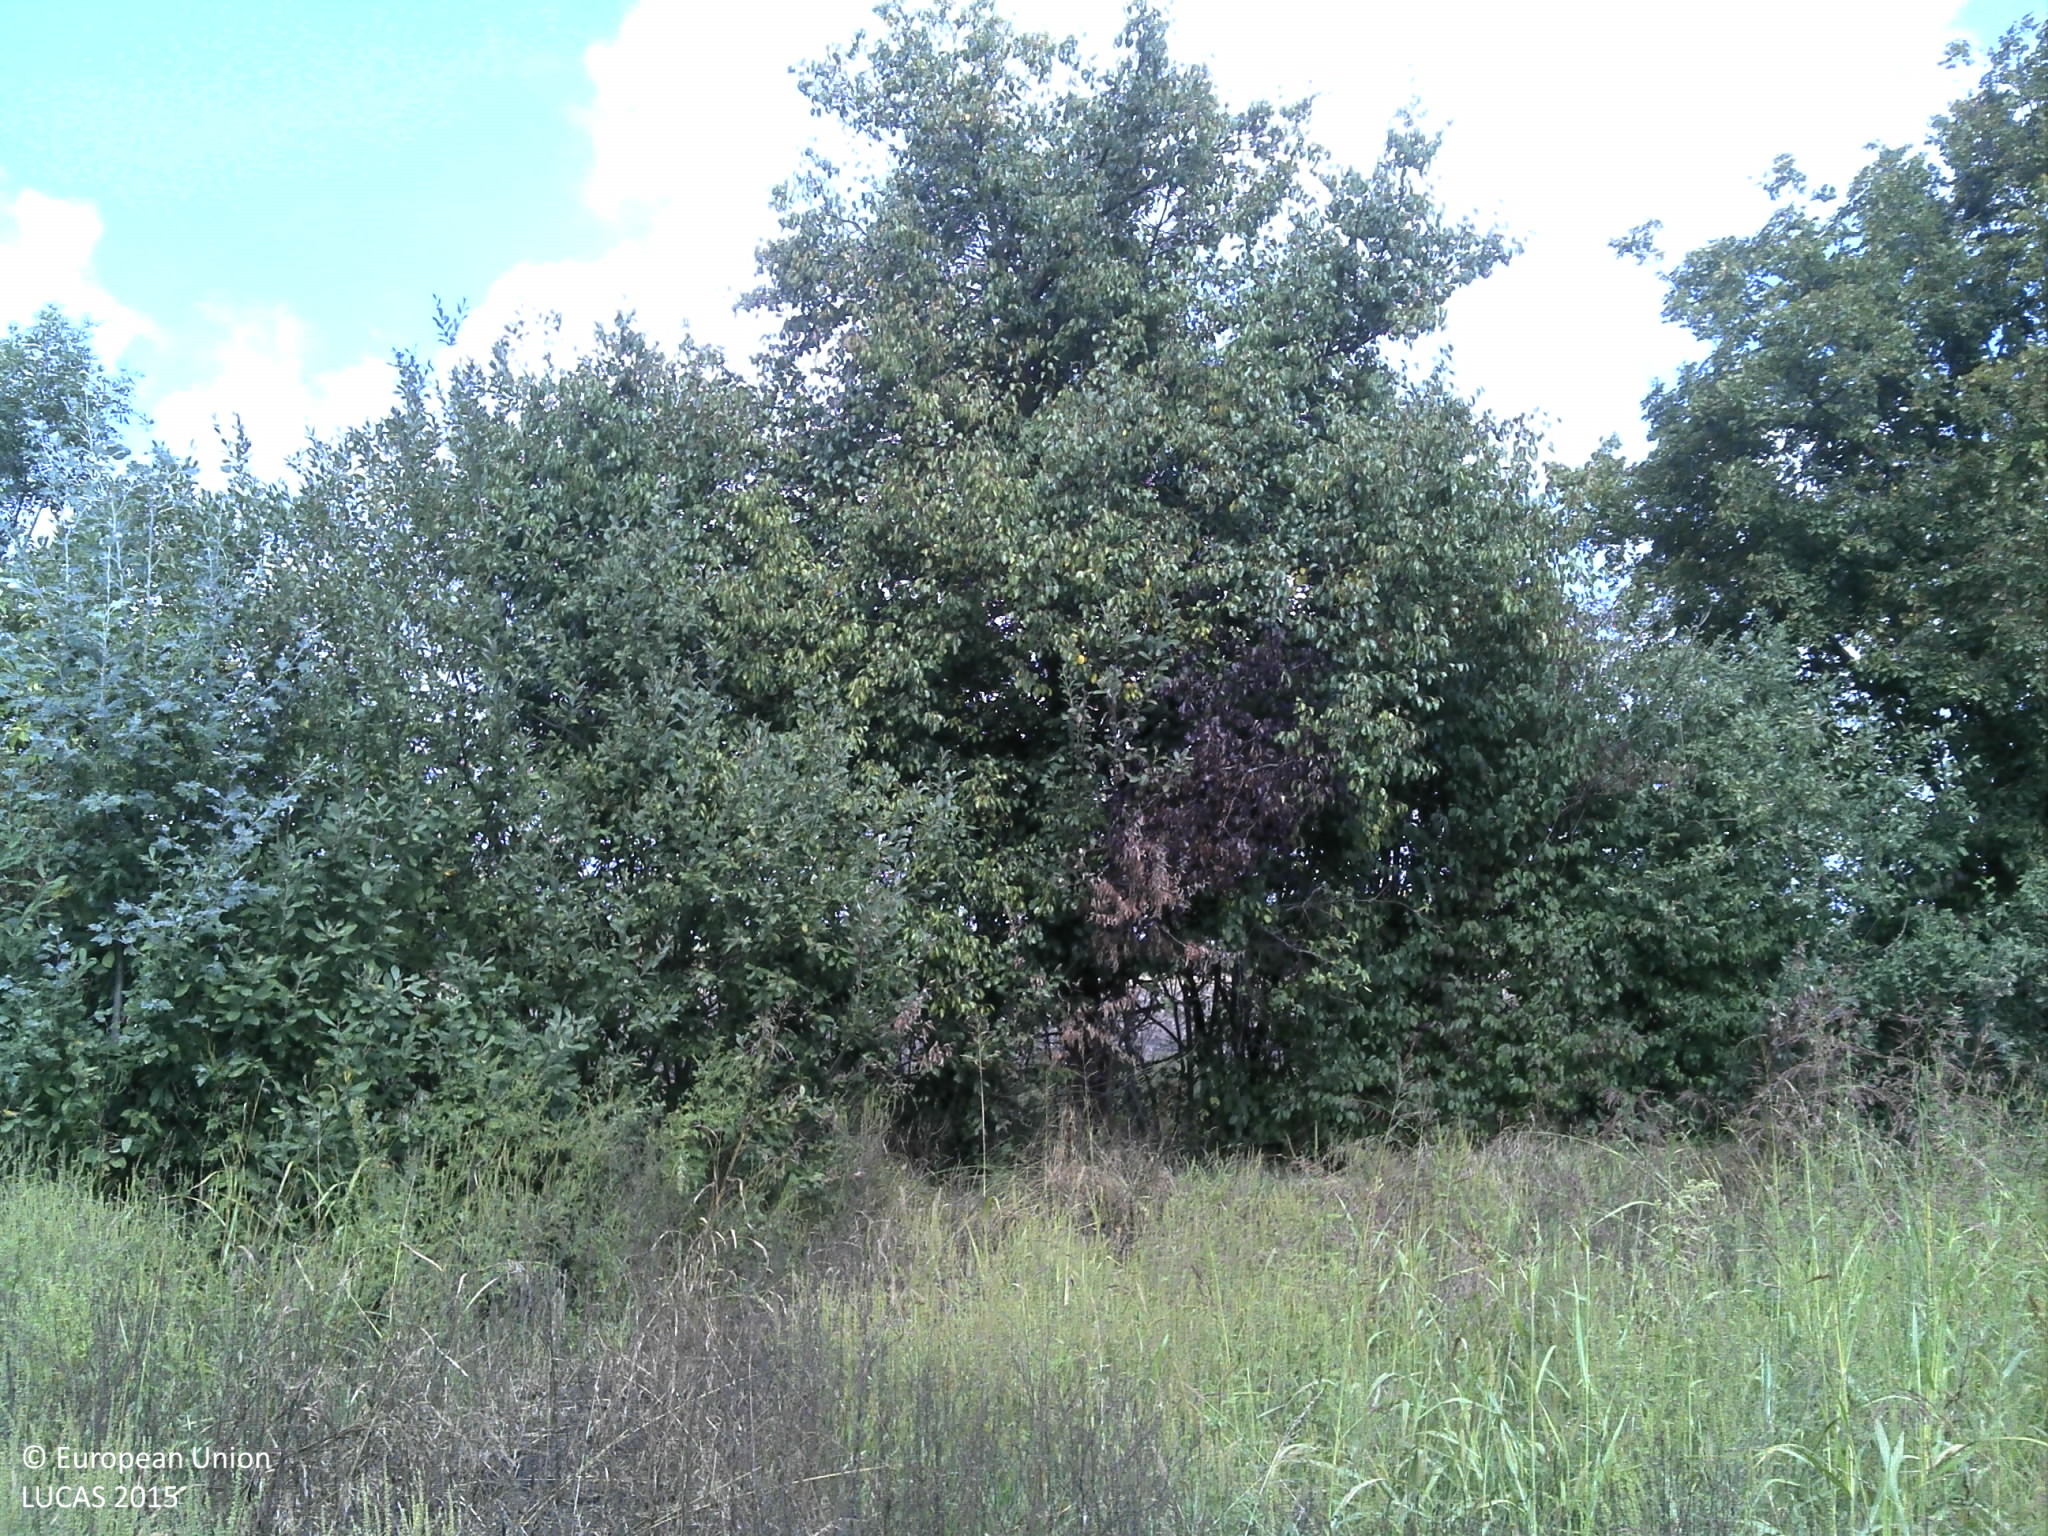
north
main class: Grassland
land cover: Spontaneously vegetated surfaces
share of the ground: > 75 %
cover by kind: herbaceous plants 100 %
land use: Agriculture (excluding fallow land and kitchen gardens)
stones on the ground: < 10 %
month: September
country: HR
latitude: 45.1219
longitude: 18.9701
